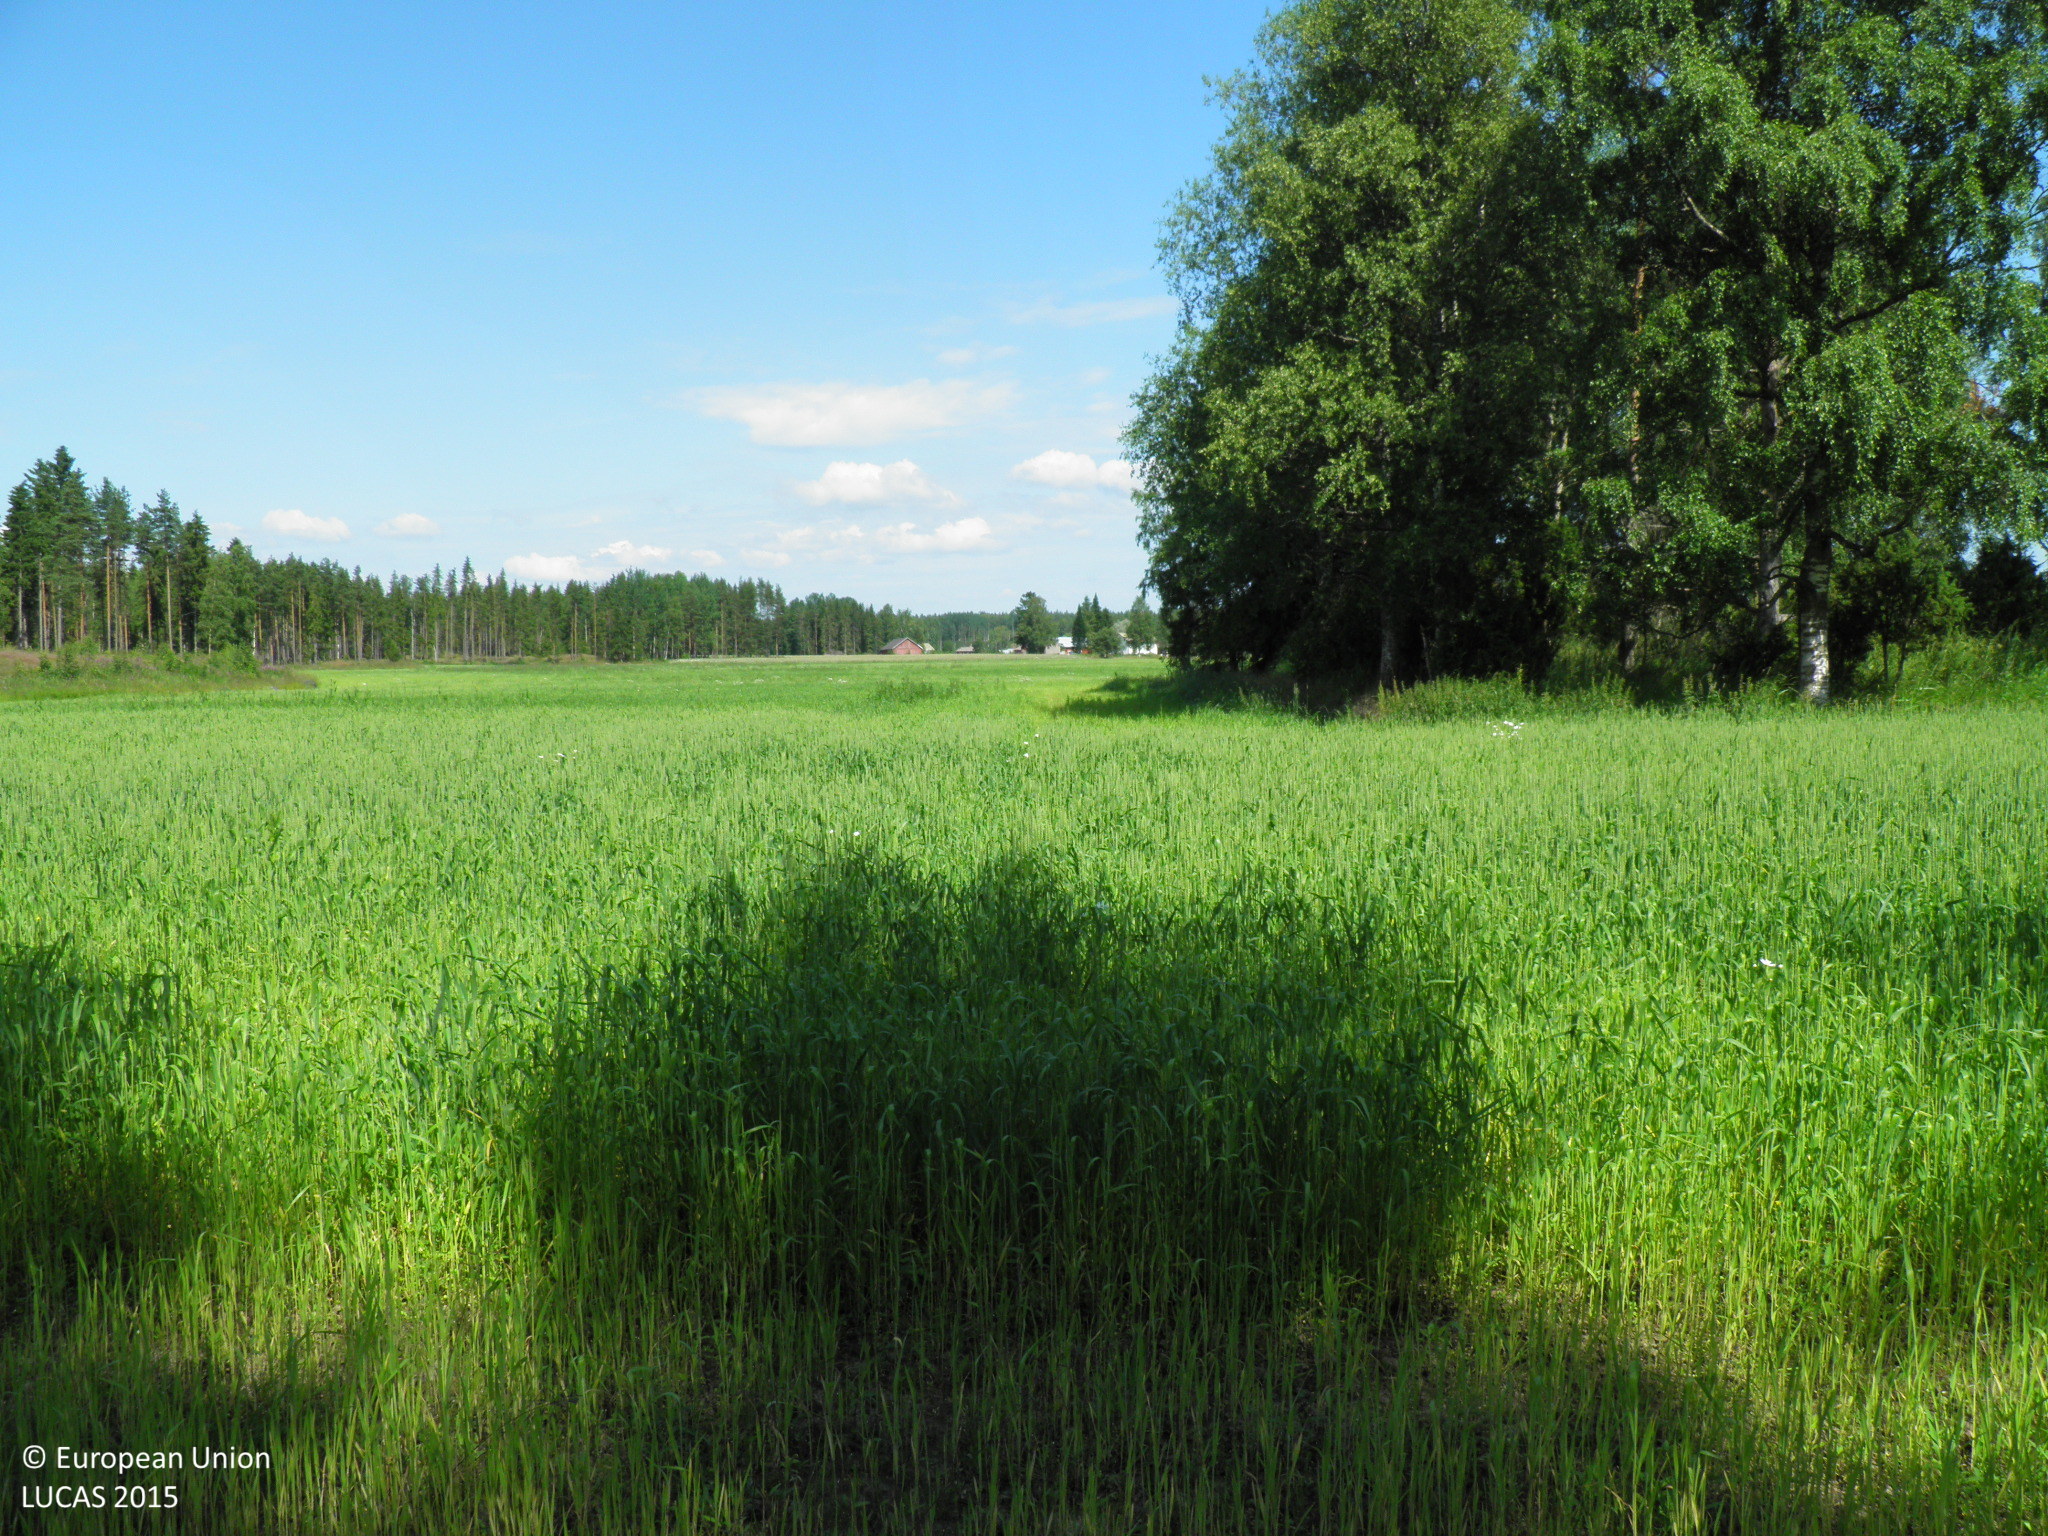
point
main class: Cropland
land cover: Common wheat
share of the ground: > 75 %
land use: Agriculture (excluding fallow land and kitchen gardens)
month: July
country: FI
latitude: 60.9205
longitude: 22.4805
